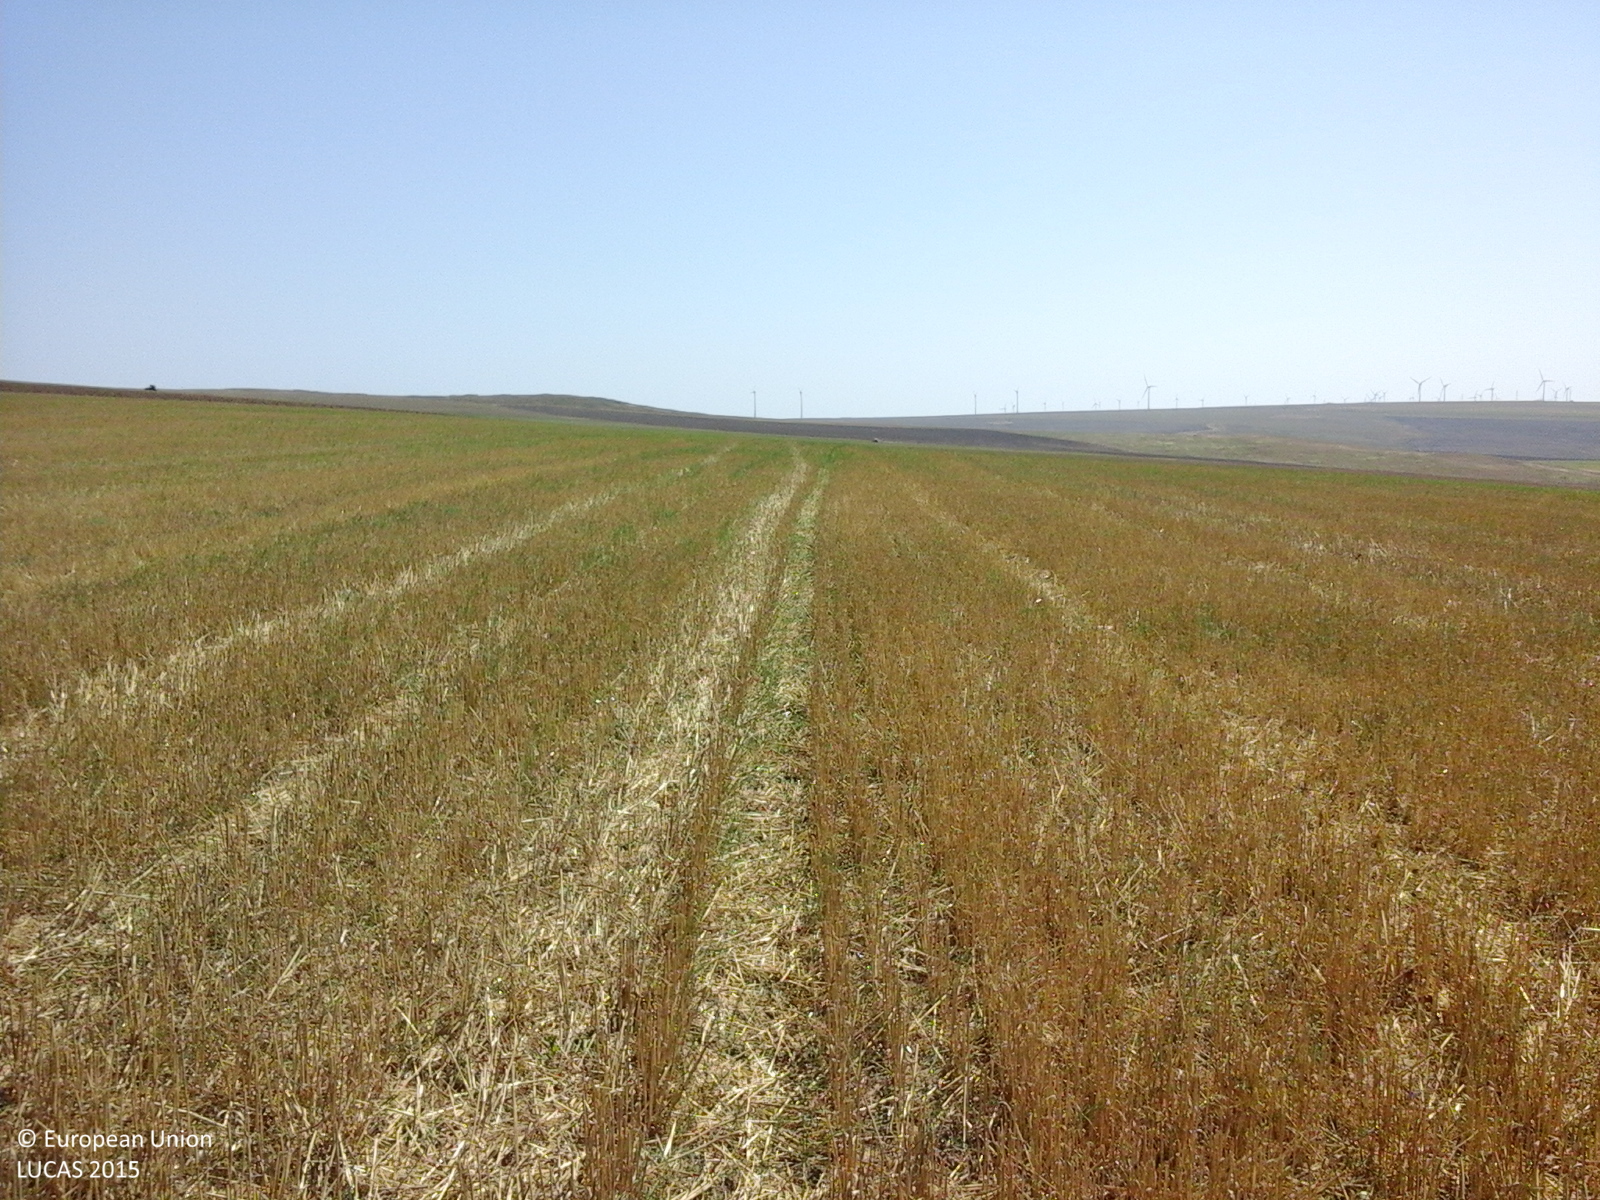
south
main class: Cropland
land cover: Common wheat
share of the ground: > 75 %
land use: Agriculture (excluding fallow land and kitchen gardens)
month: August
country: RO
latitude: 44.7062
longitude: 28.6725
